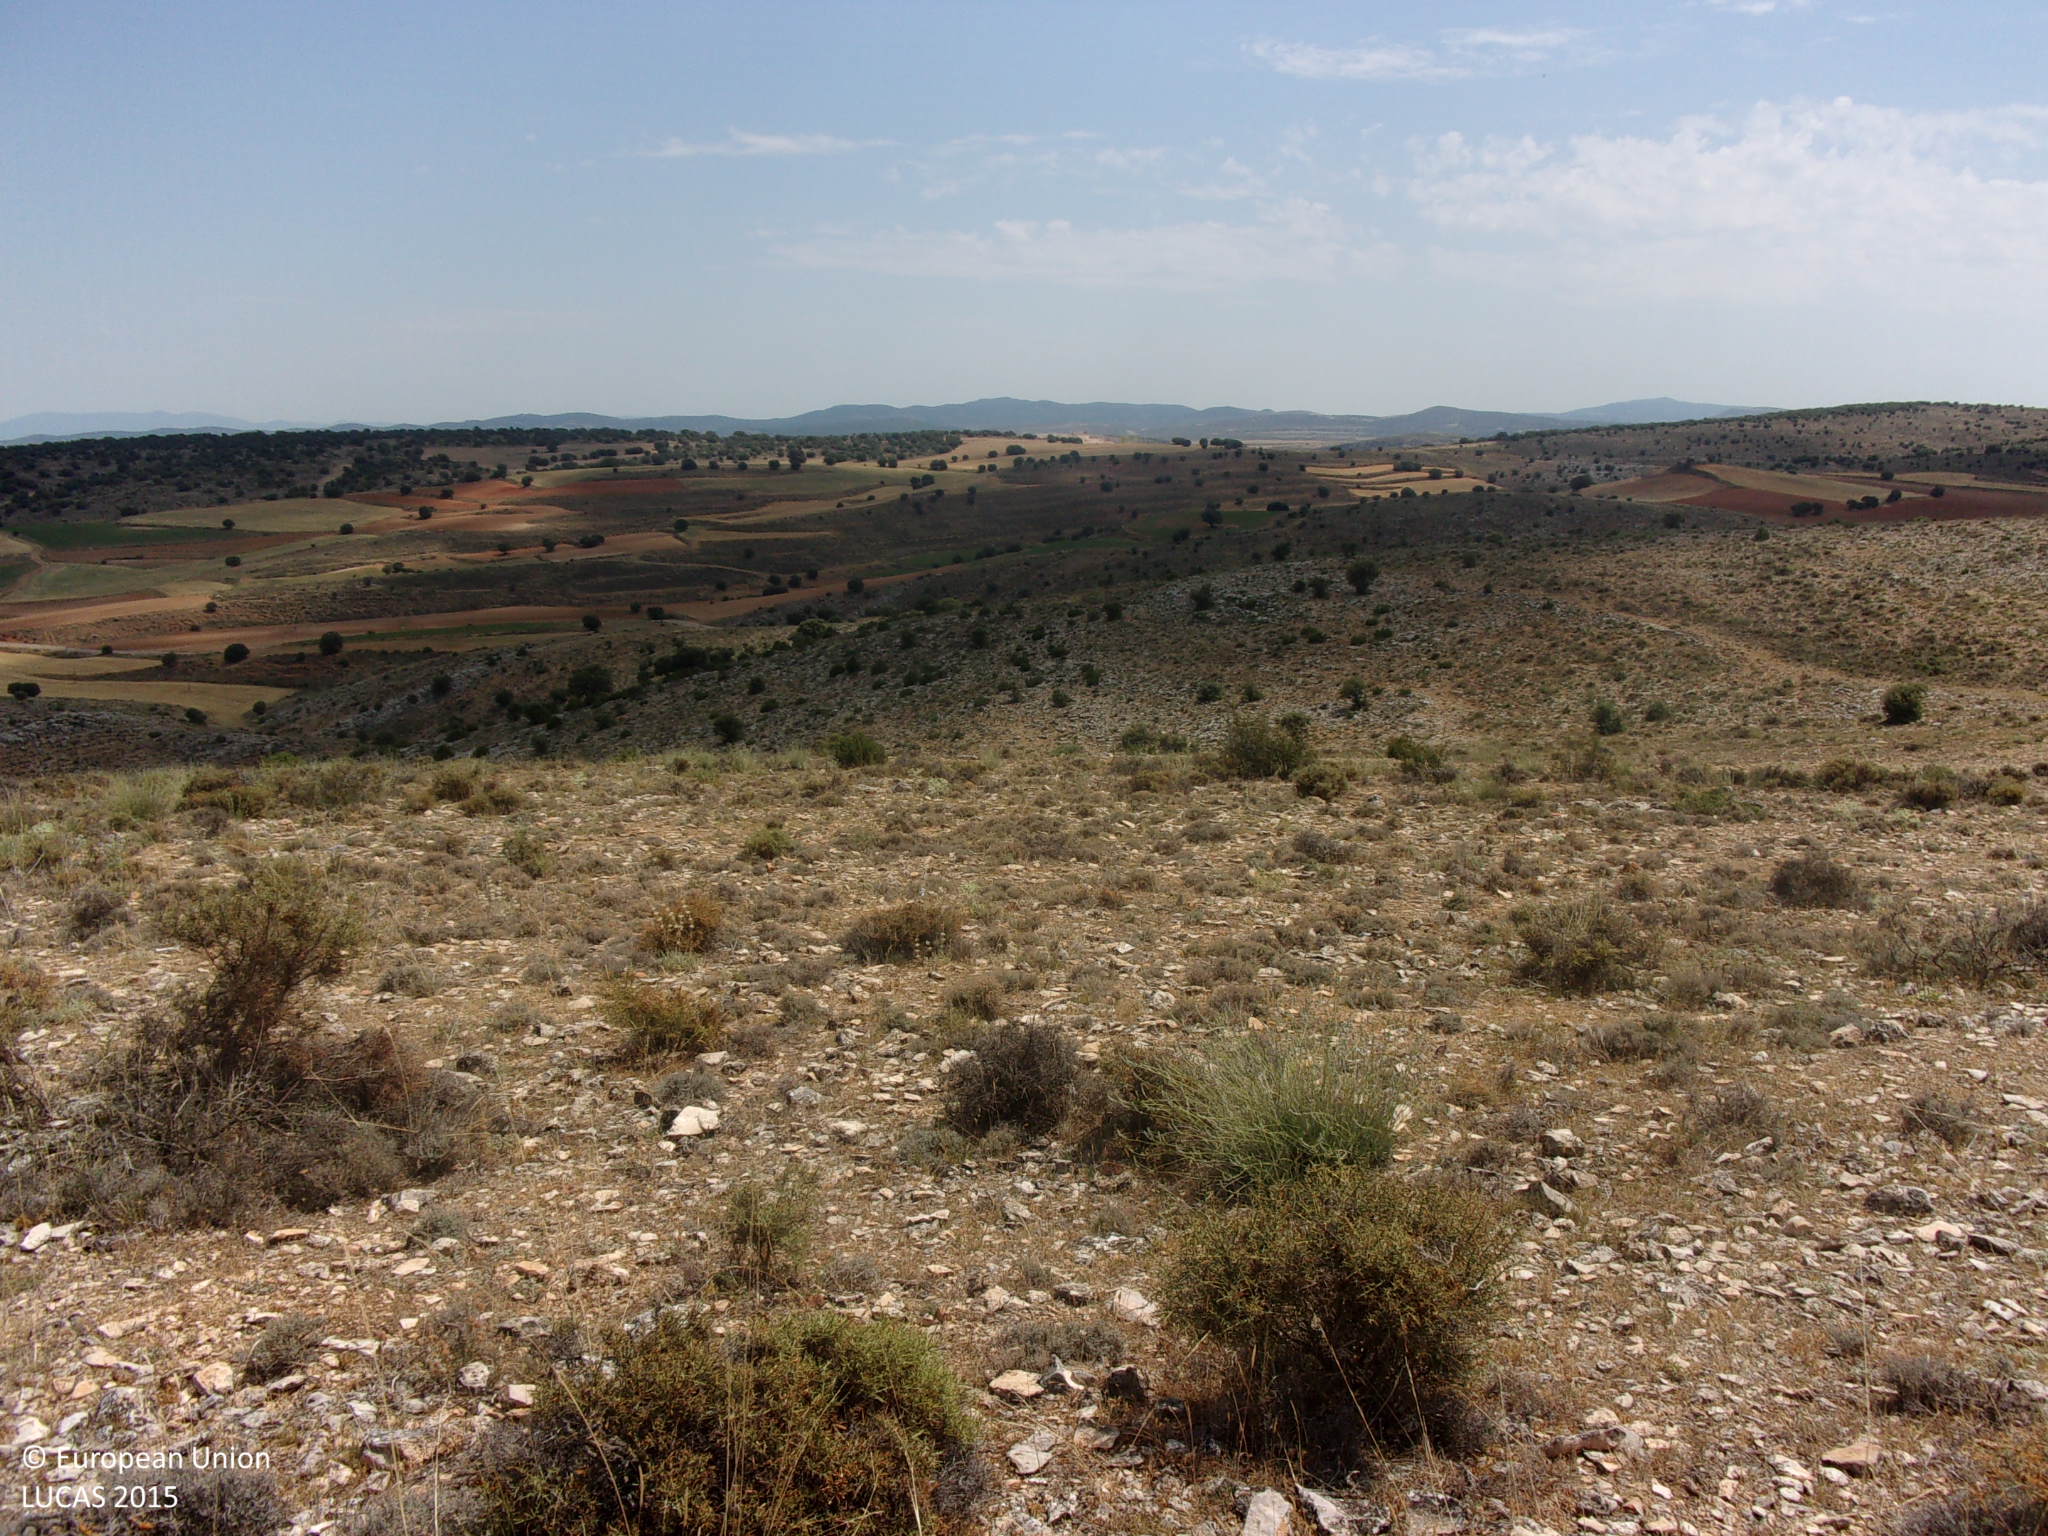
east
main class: Shrubland
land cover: Shrubland without tree cover
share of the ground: 50 - 75 %
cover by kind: consolidated bare surface 50 %, shrubs 40 %, herbaceous plants 10 %
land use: Semi-natural and natural areas not in use
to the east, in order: Shrubland without tree cover
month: July
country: ES
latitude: 41.1372
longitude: -1.8308
